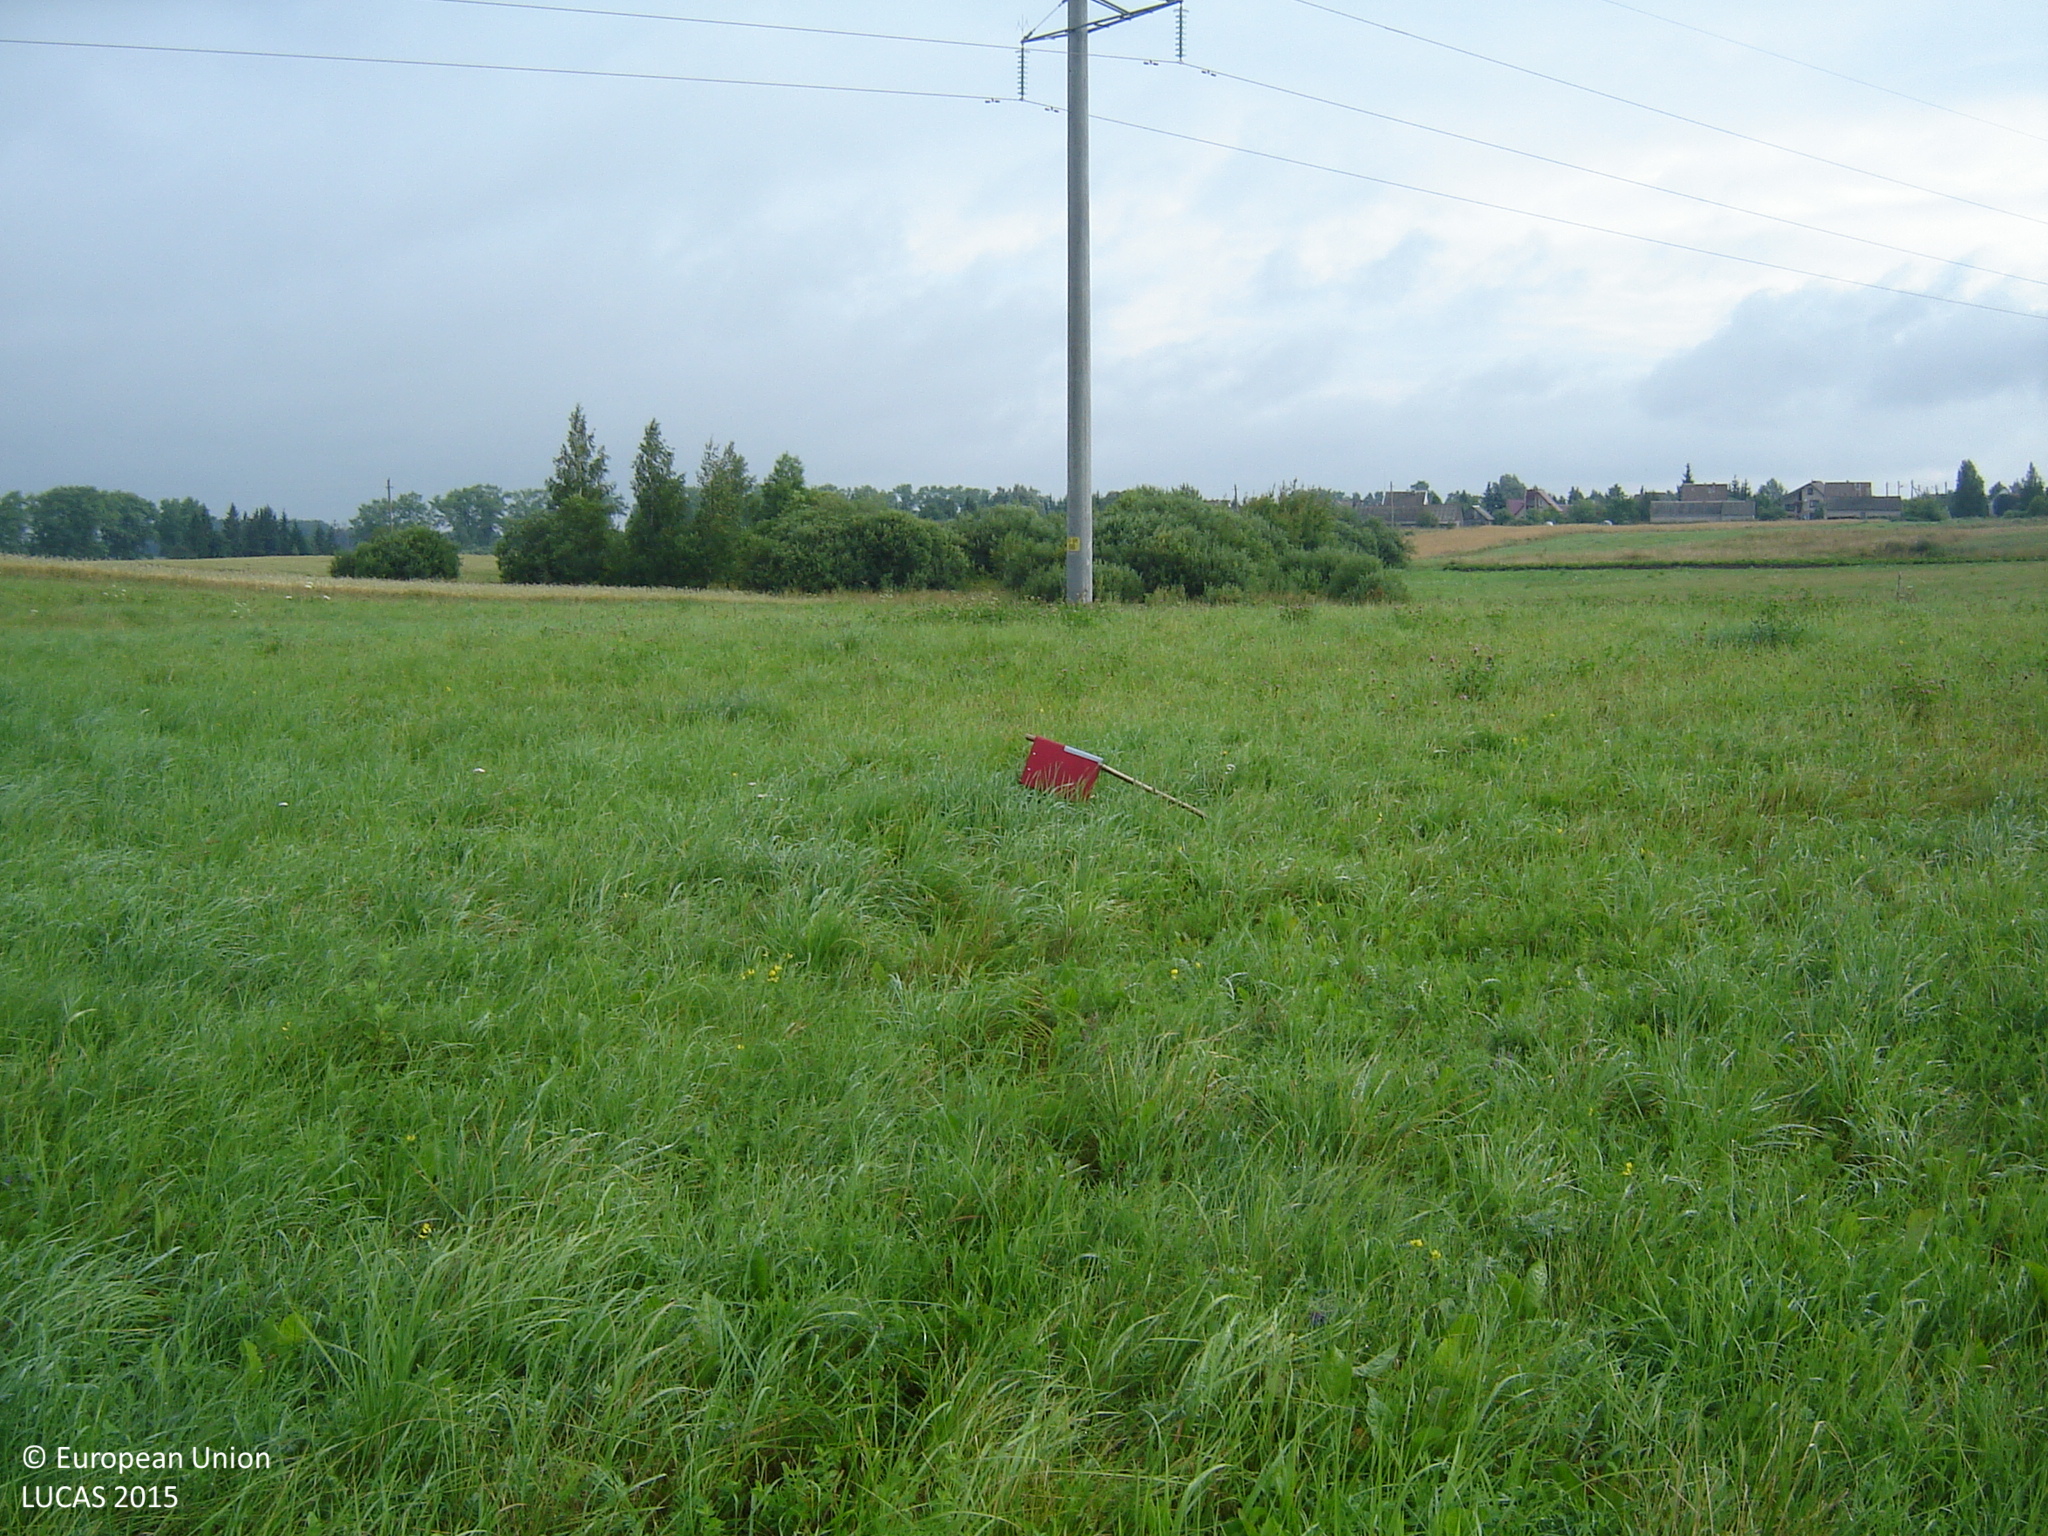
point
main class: Grassland
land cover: Grassland without tree/shrub cover
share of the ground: > 75 %
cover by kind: herbaceous plants 100 %
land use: Agriculture (excluding fallow land and kitchen gardens)
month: July
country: LT
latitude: 55.3692
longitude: 25.0234
